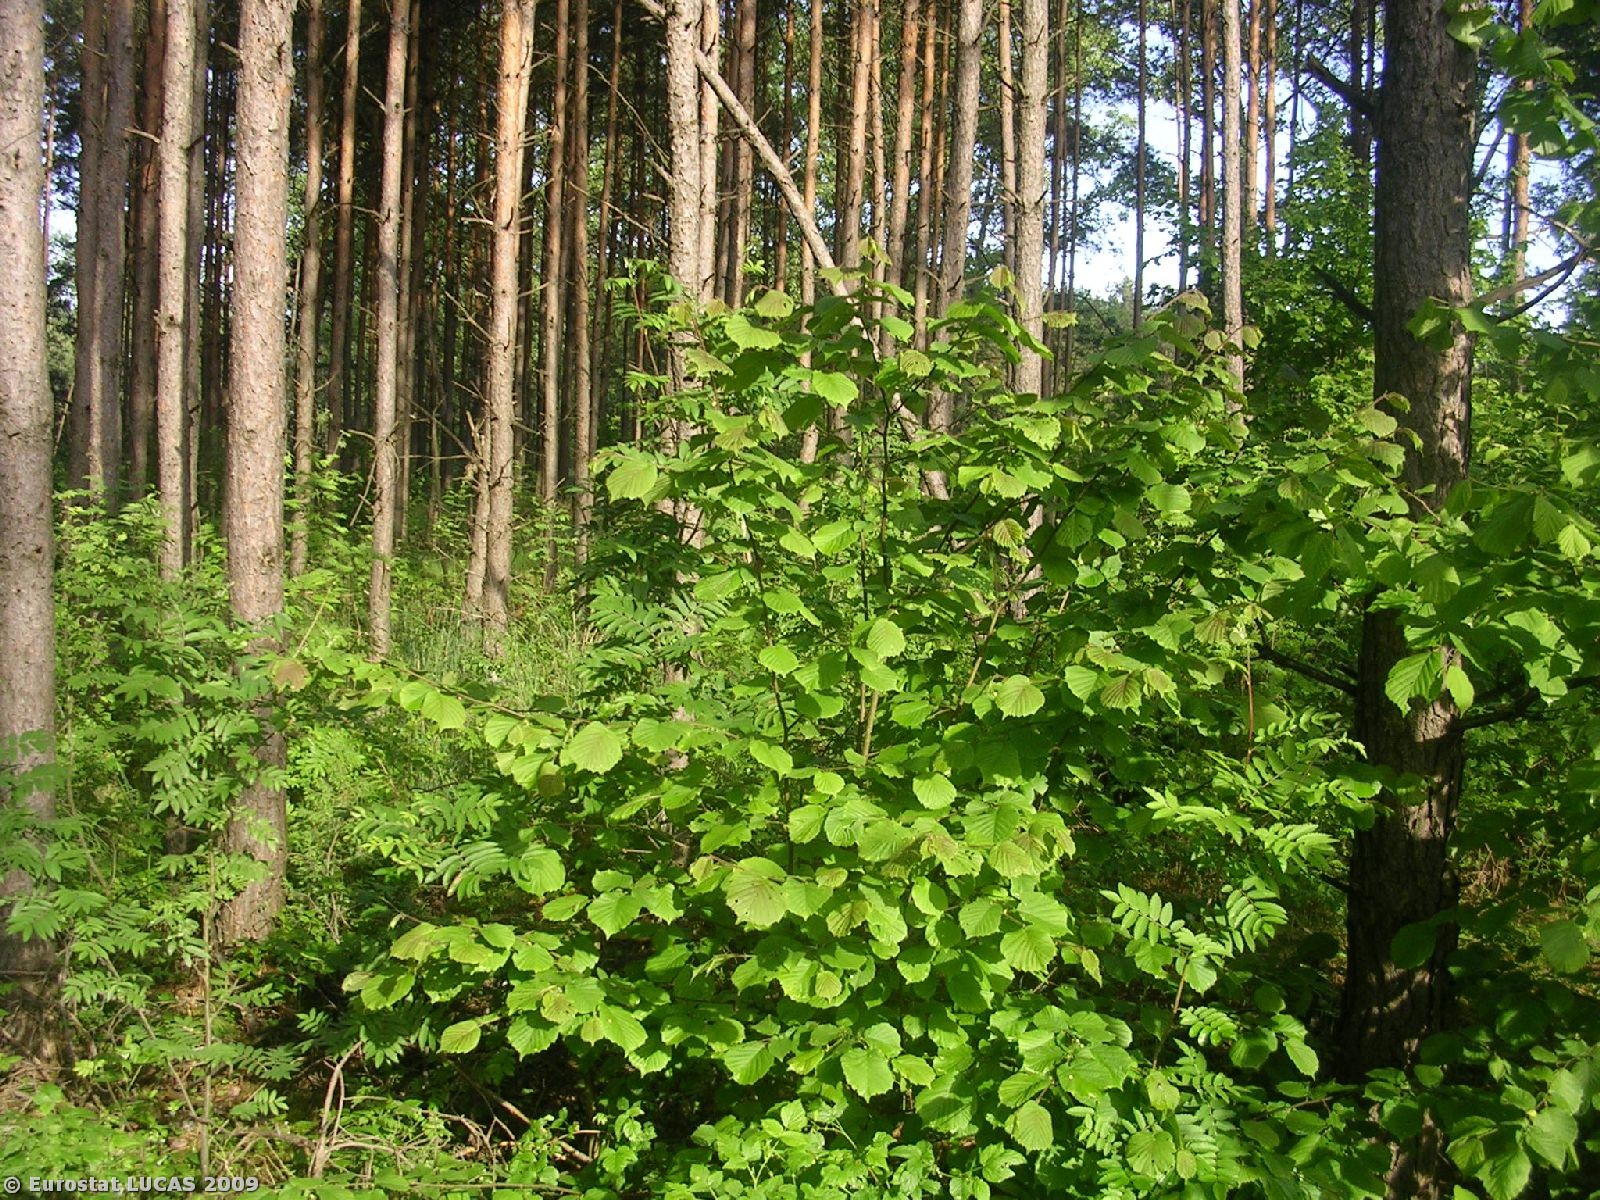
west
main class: Woodland
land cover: Mixed woodland
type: hemiboreal forest and nemoral coniferous forest and mixed broadleaved-coniferous forest
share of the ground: 25 - 50 %
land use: Forestry
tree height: > 5 m
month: May
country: PL
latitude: 53.2350
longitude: 23.2483
